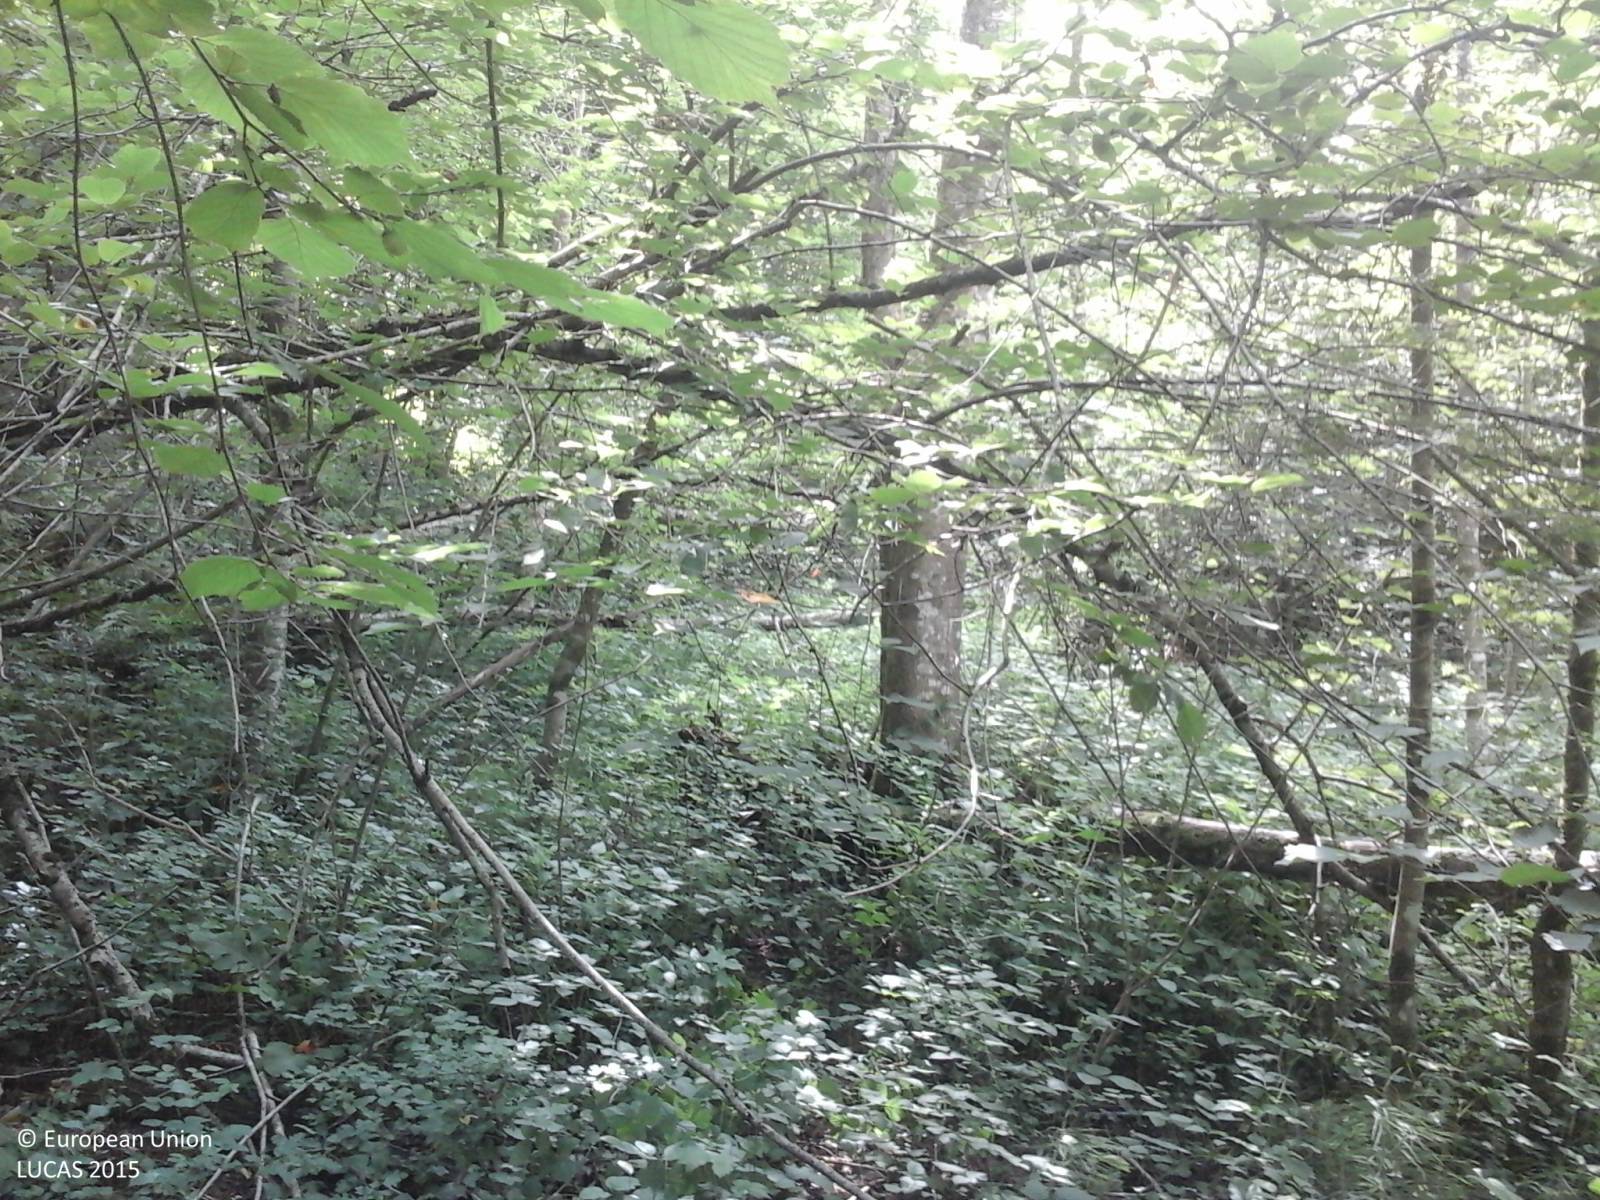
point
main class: Woodland
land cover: Broadleaved woodland
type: mesophytic deciduous forest
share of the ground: > 75 %
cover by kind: broadleaved forest trees 70 %, shrubs 20 %, herbaceous plants 10 %
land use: Forestry
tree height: > 5 m
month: July
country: IT
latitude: 46.1941
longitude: 12.5755
